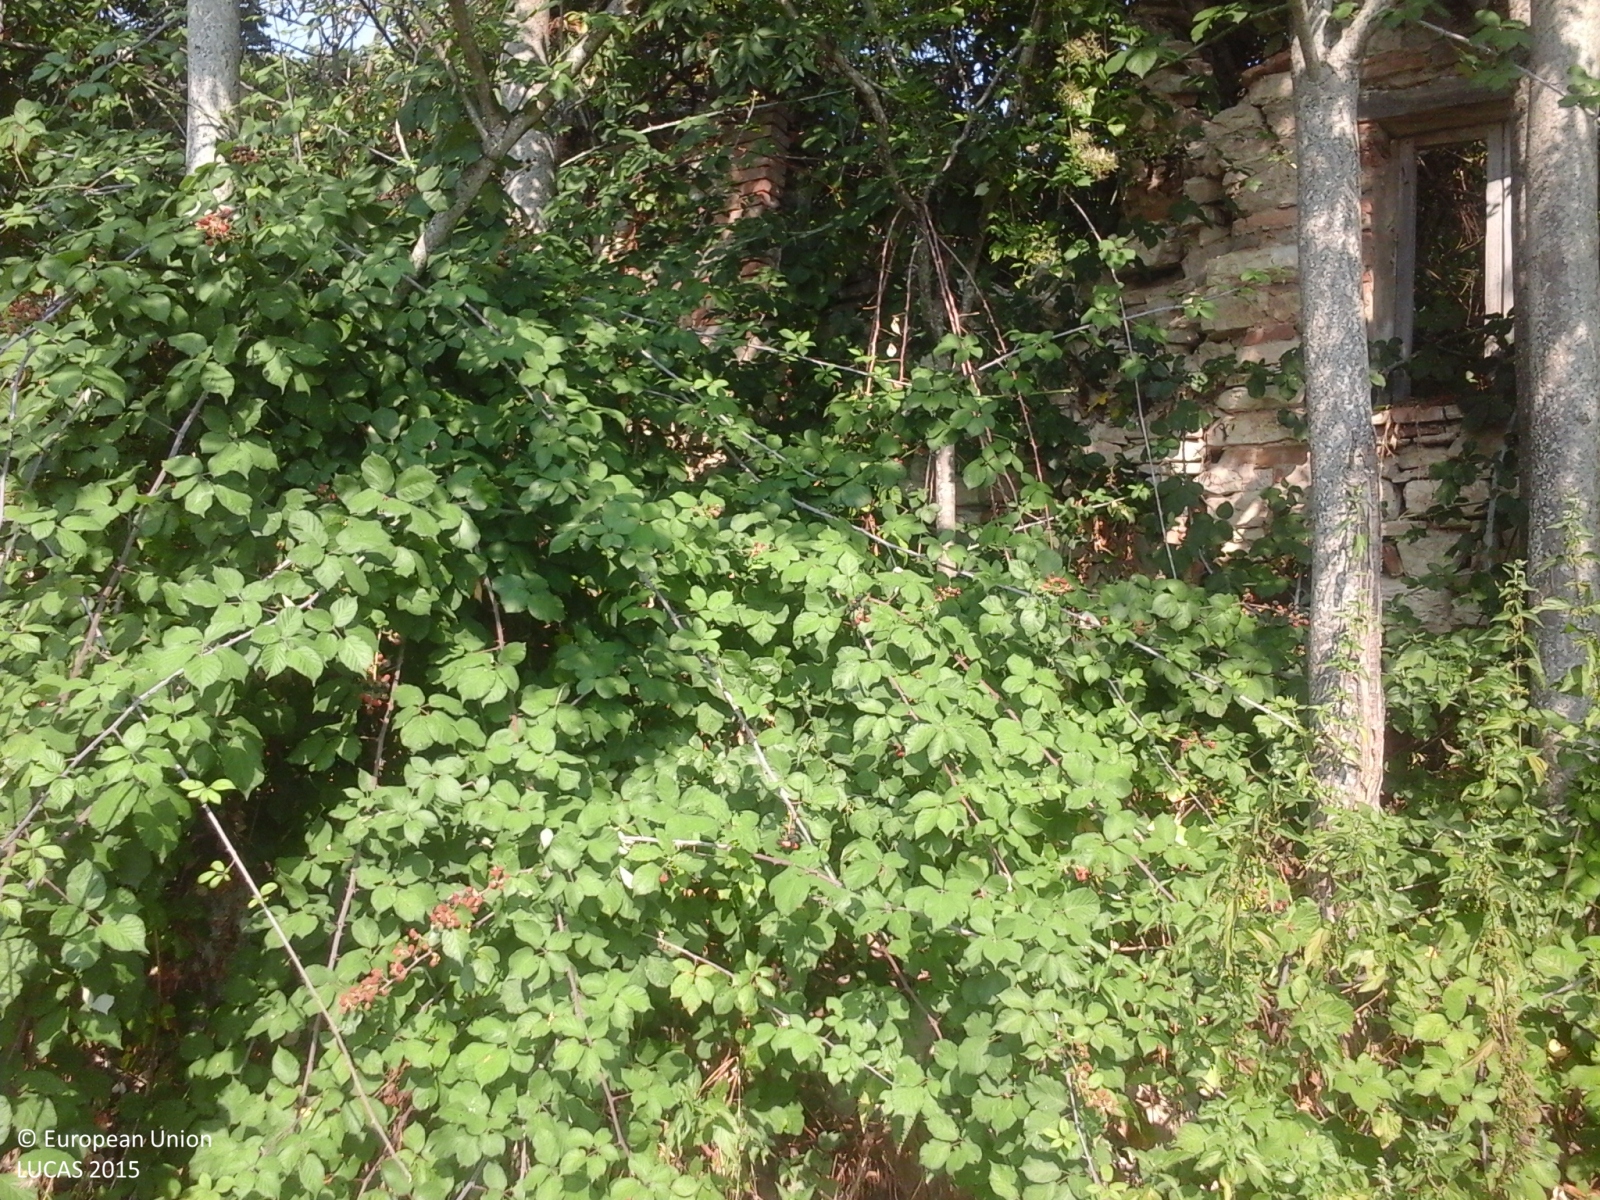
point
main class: Woodland
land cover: Broadleaved woodland
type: thermophilous deciduous forest
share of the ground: > 75 %
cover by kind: broadleaved forest trees 100 %
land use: Forestry
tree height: > 5 m
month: August
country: IT
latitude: 43.8171
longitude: 12.4185
